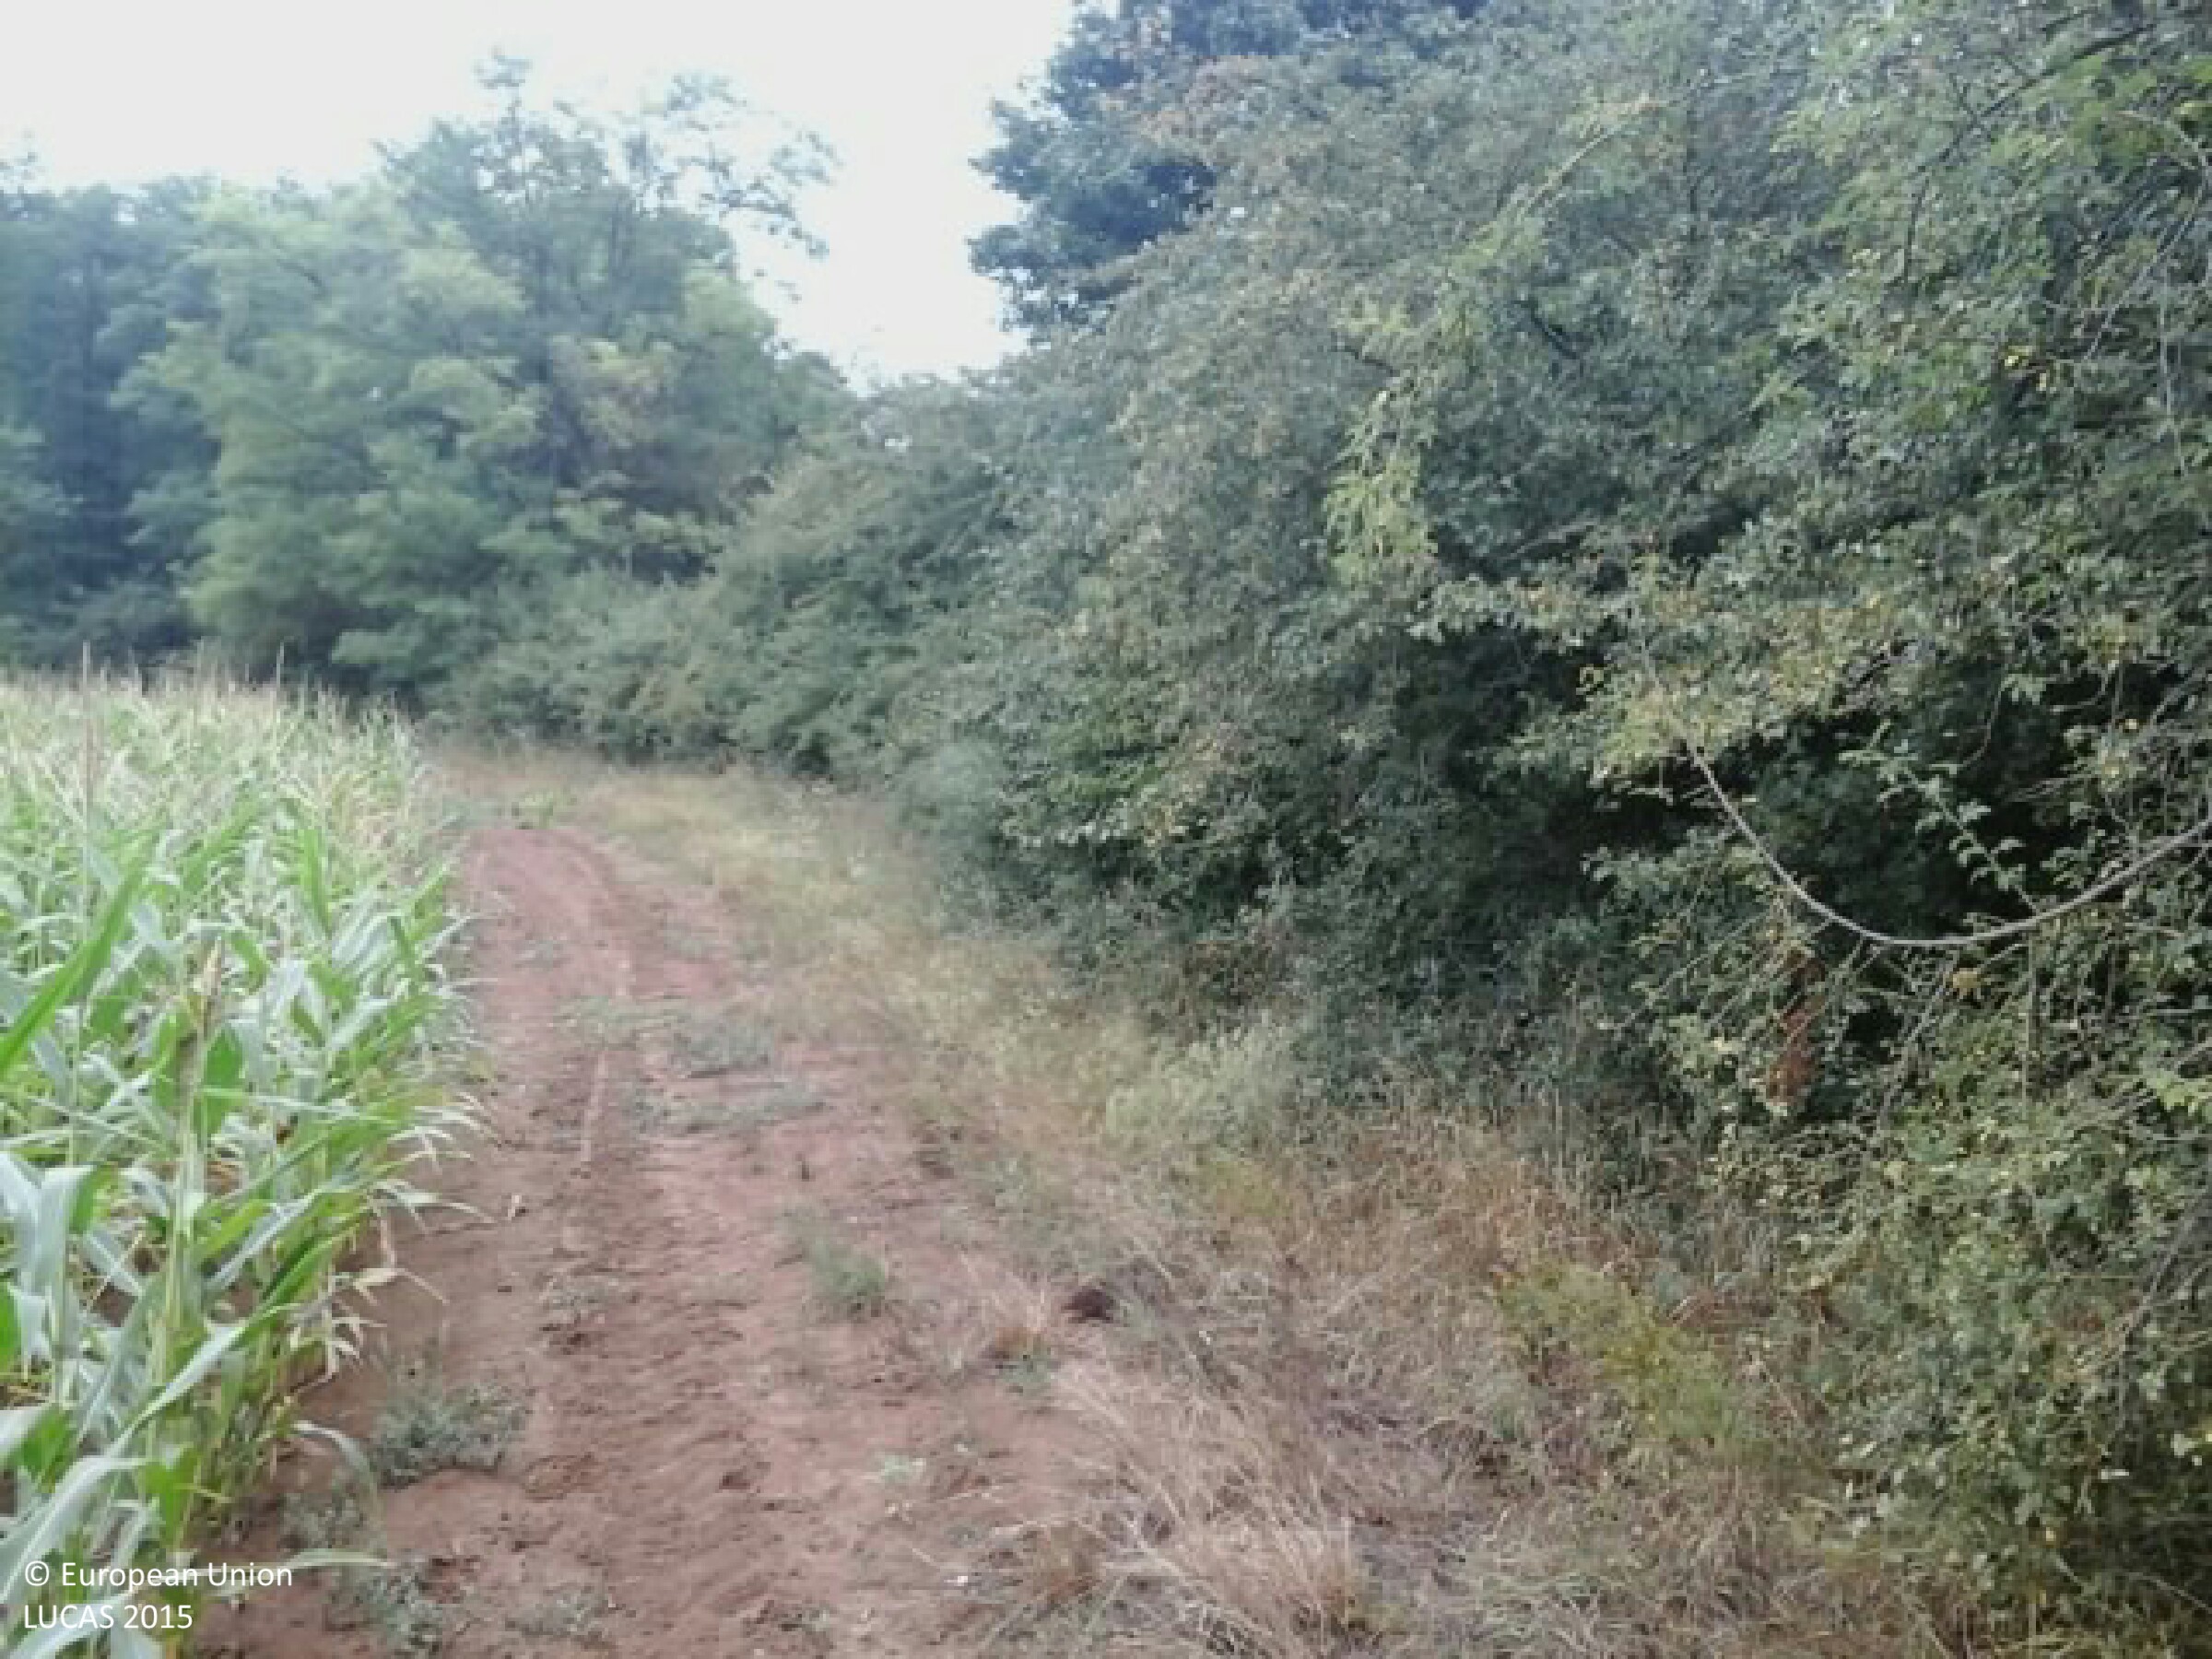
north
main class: Cropland
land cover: Maize
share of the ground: > 75 %
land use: Agriculture (excluding fallow land and kitchen gardens)
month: August
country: HU
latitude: 46.2176
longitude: 17.9527
